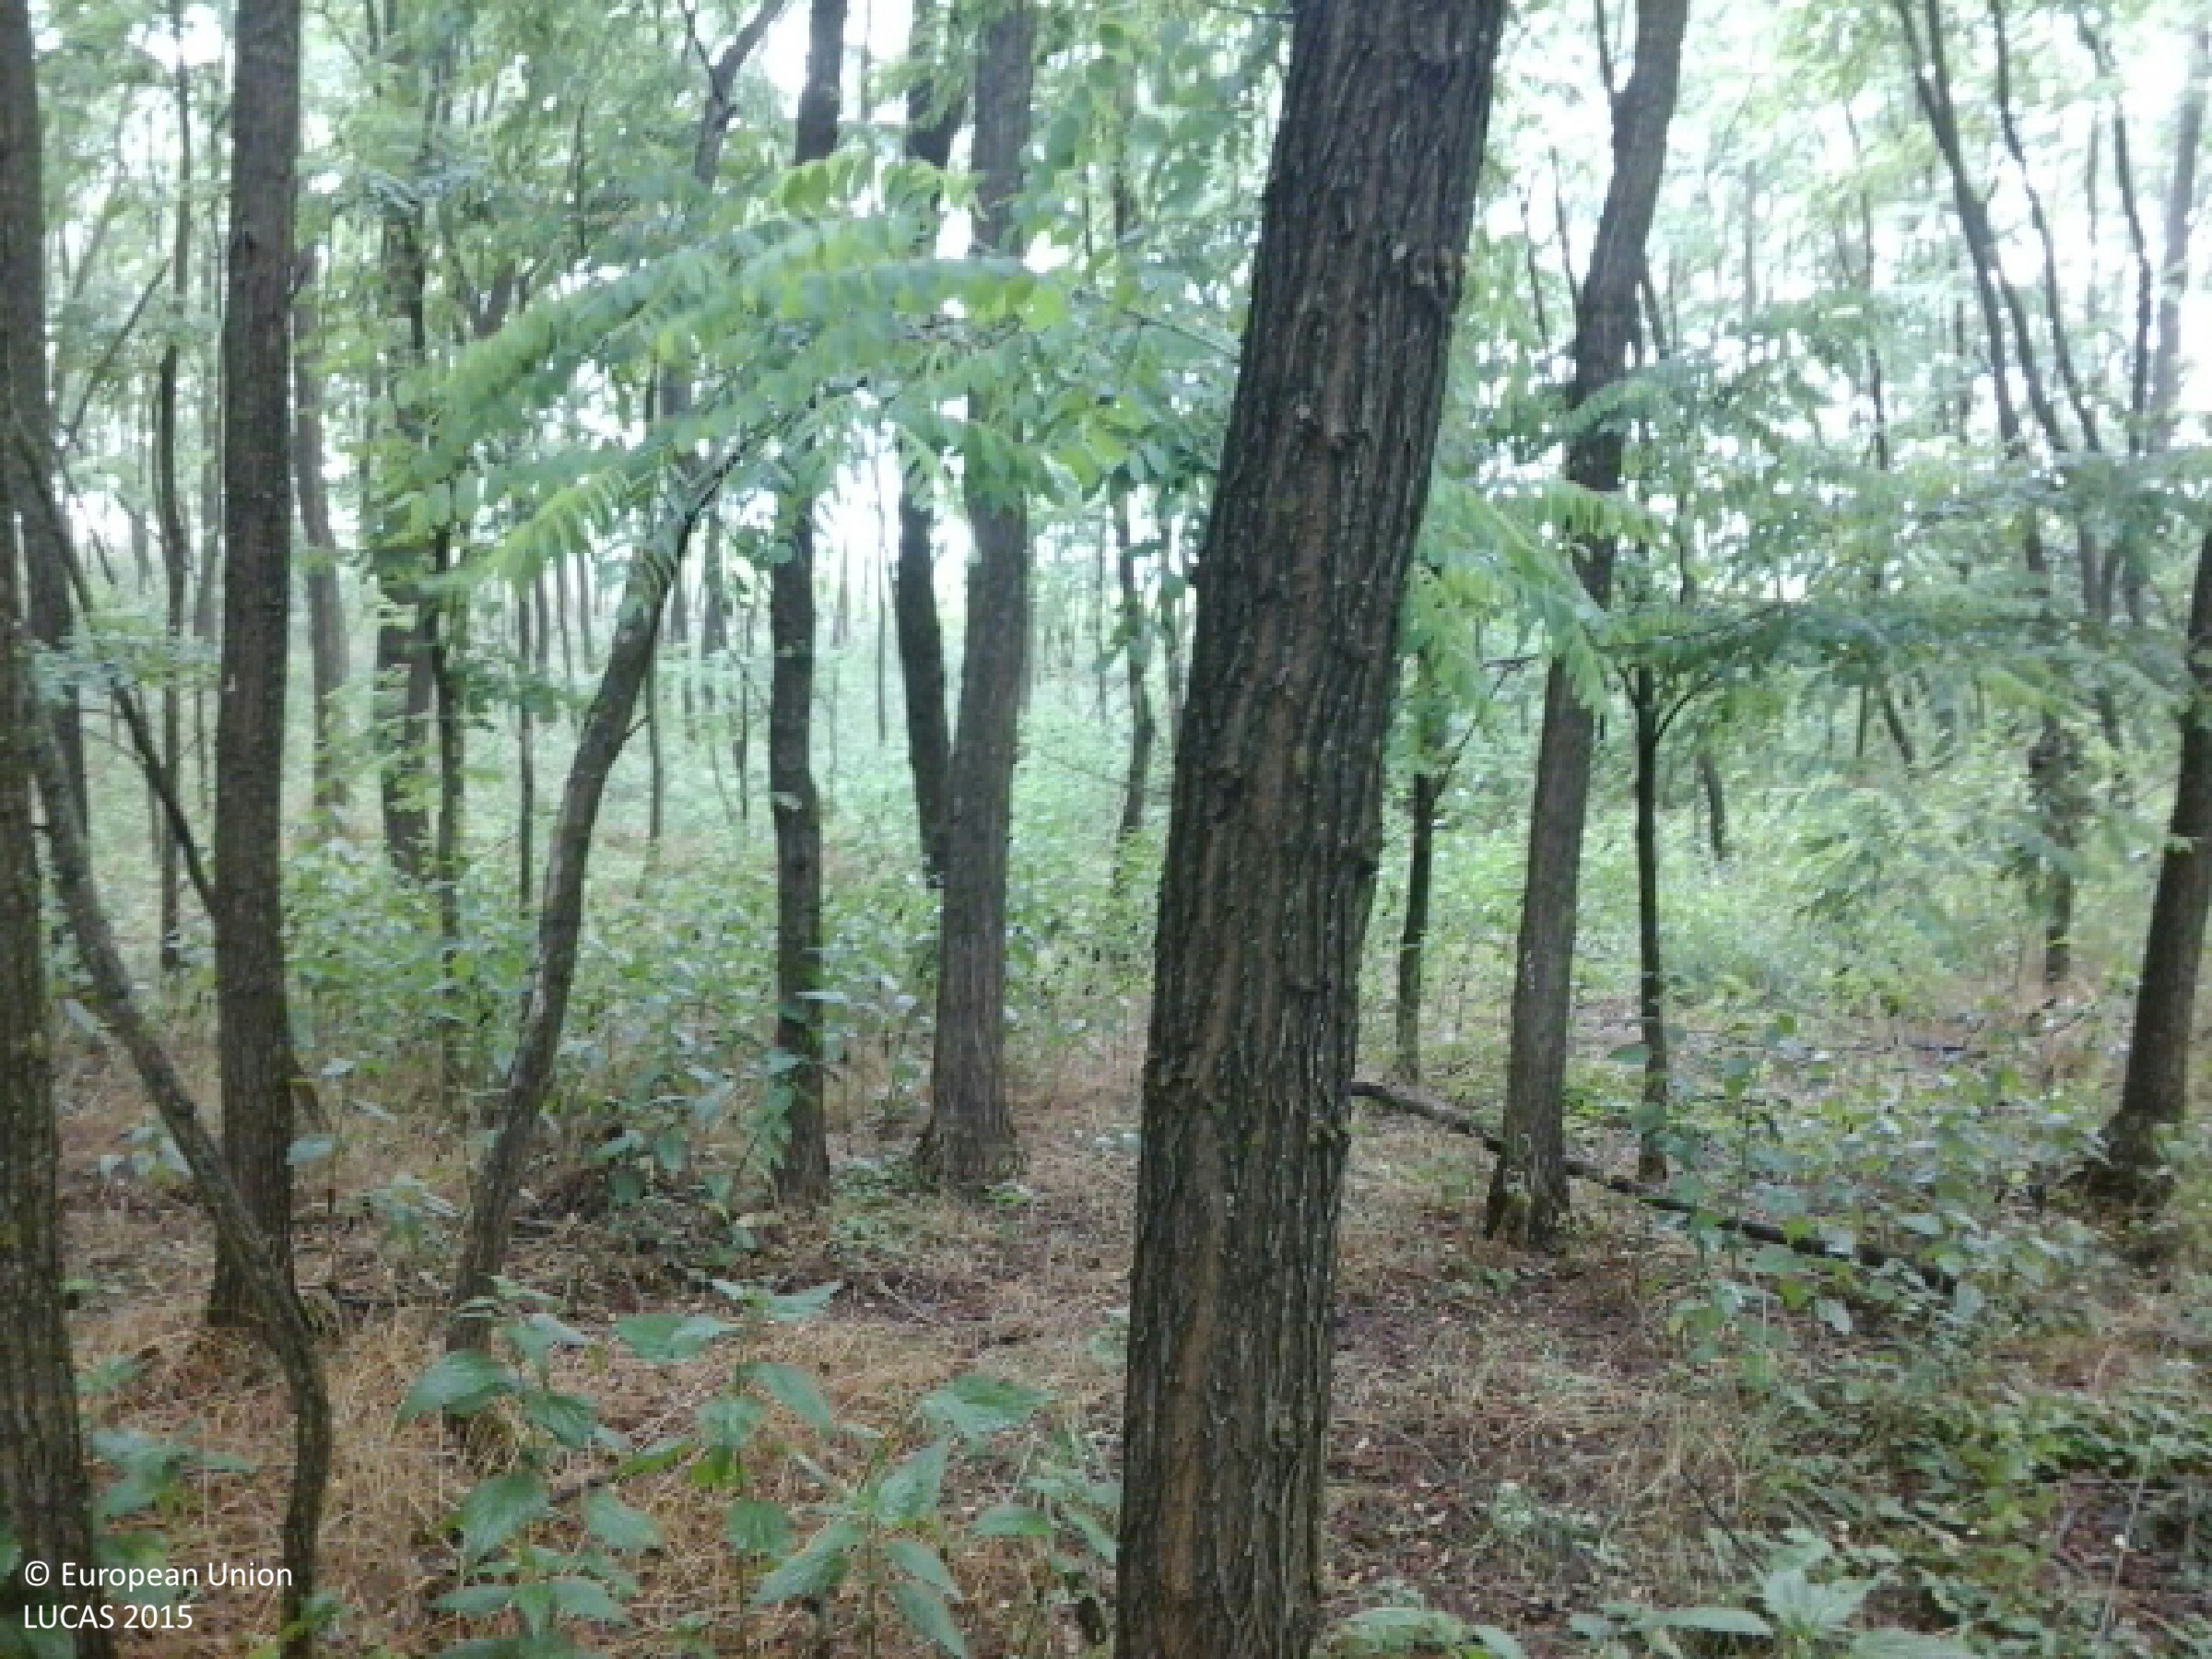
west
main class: Woodland
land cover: Broadleaved woodland
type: mesophytic deciduous forest
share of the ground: > 75 %
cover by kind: broadleaved forest trees 95 %, herbaceous plants 5 %
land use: Forestry
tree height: > 5 m
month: June
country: HU
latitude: 48.0202
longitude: 21.9985
